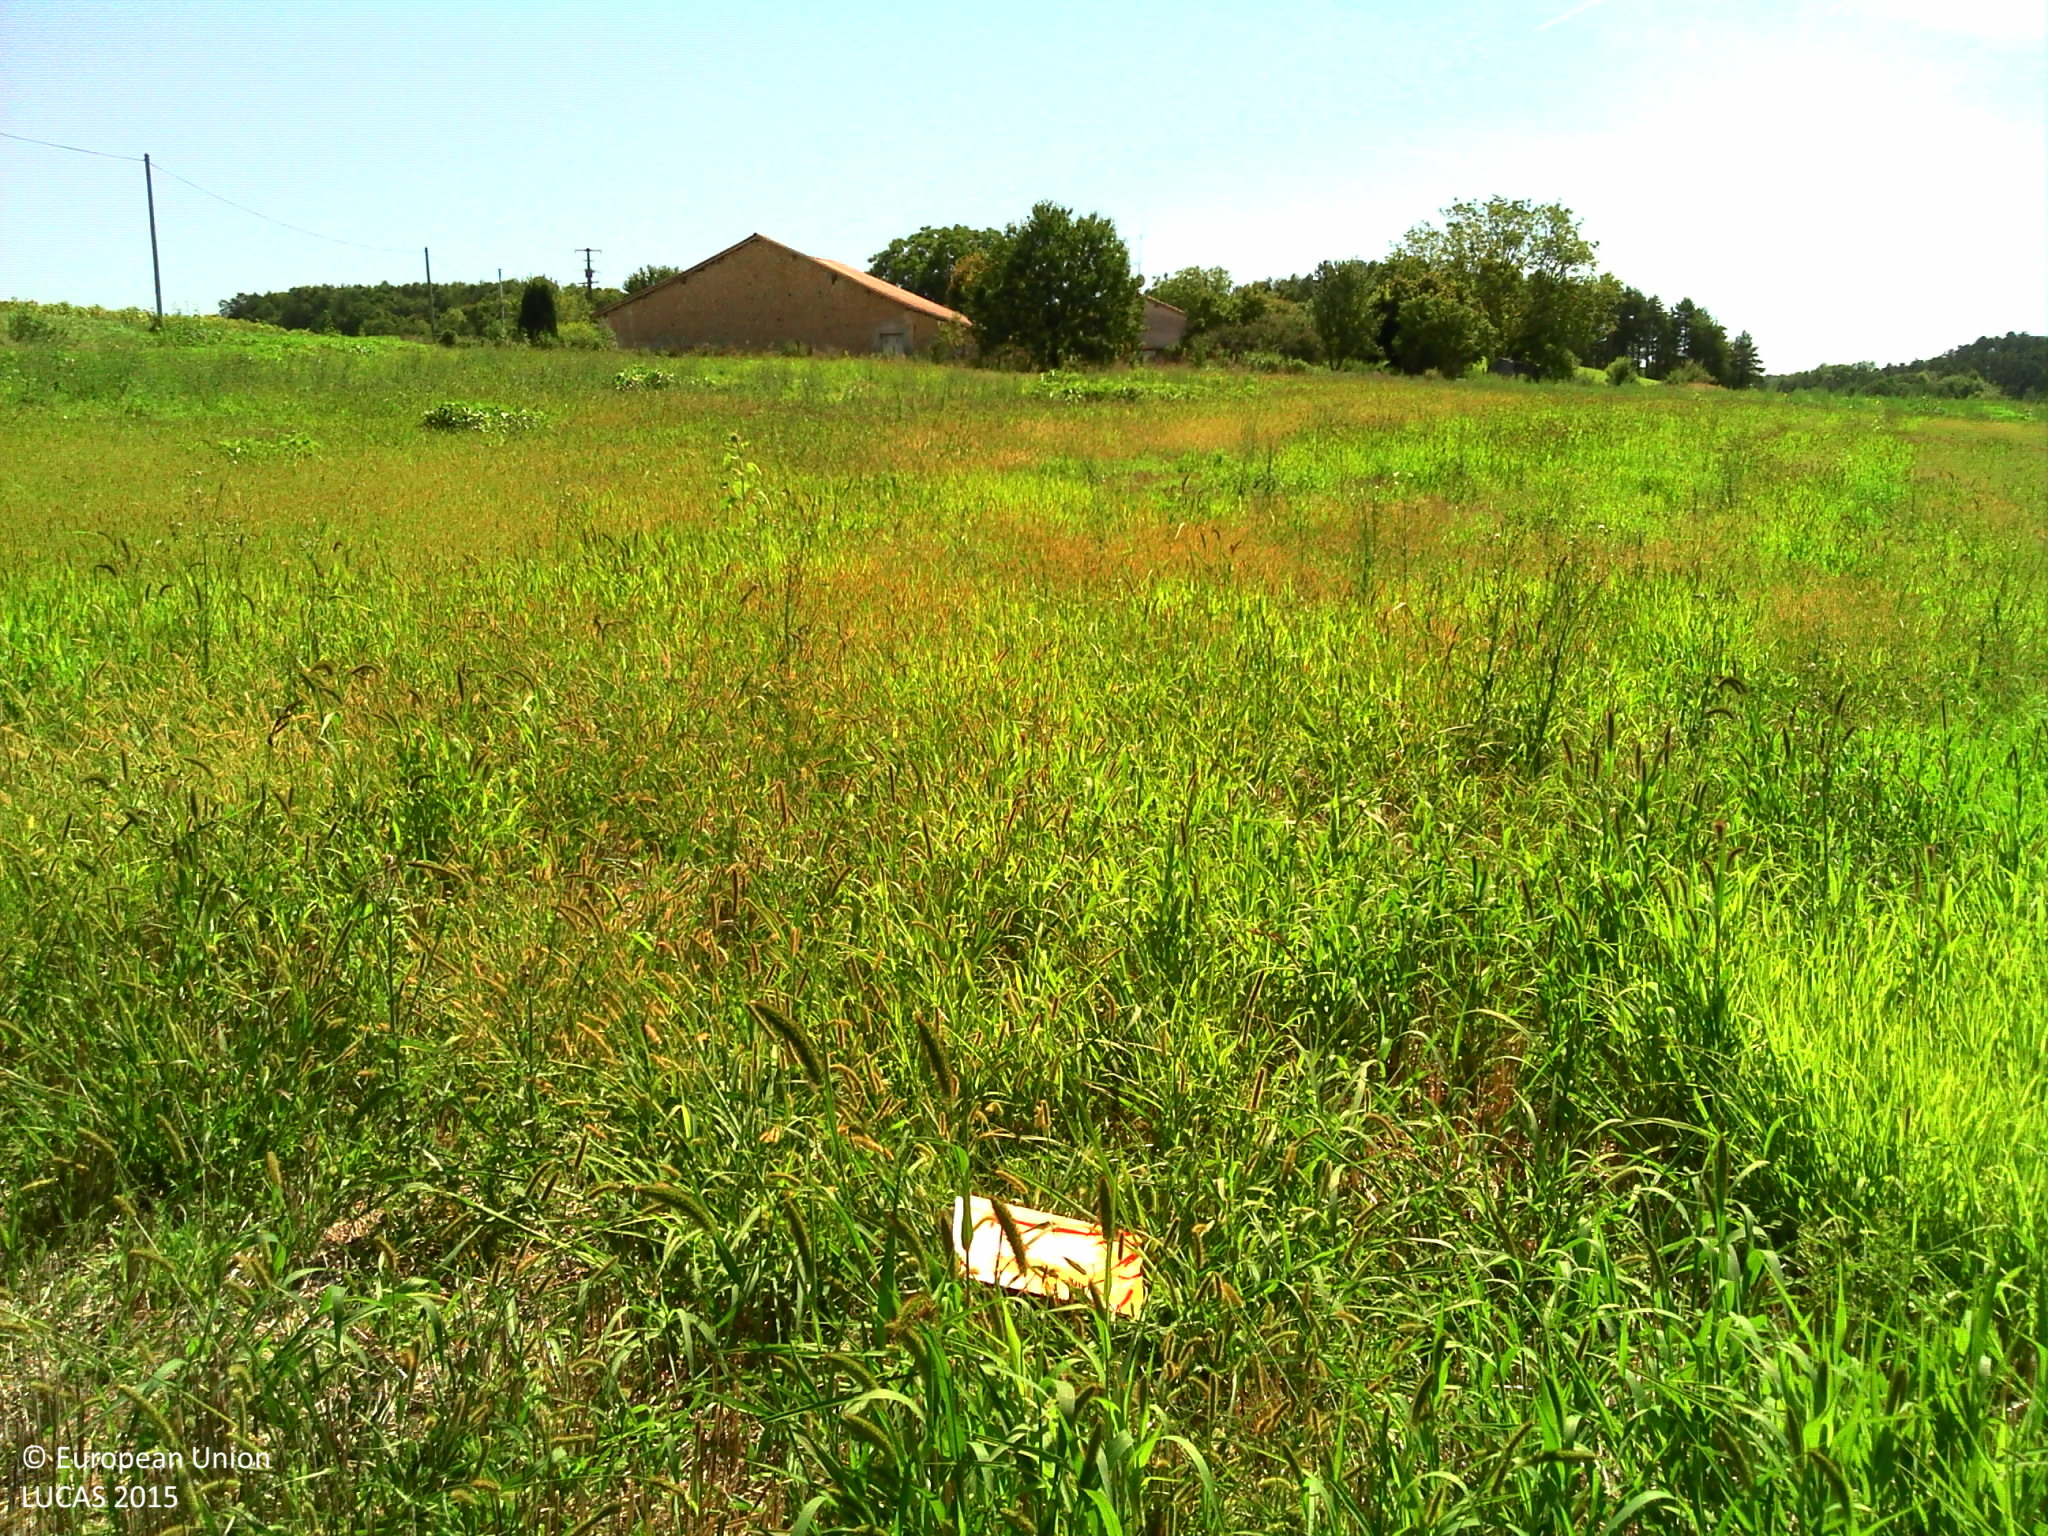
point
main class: Grassland
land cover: Grassland without tree/shrub cover
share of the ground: > 75 %
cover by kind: herbaceous plants 100 %
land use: Agriculture (excluding fallow land and kitchen gardens)
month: August
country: FR
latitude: 45.2382
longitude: 0.4979
